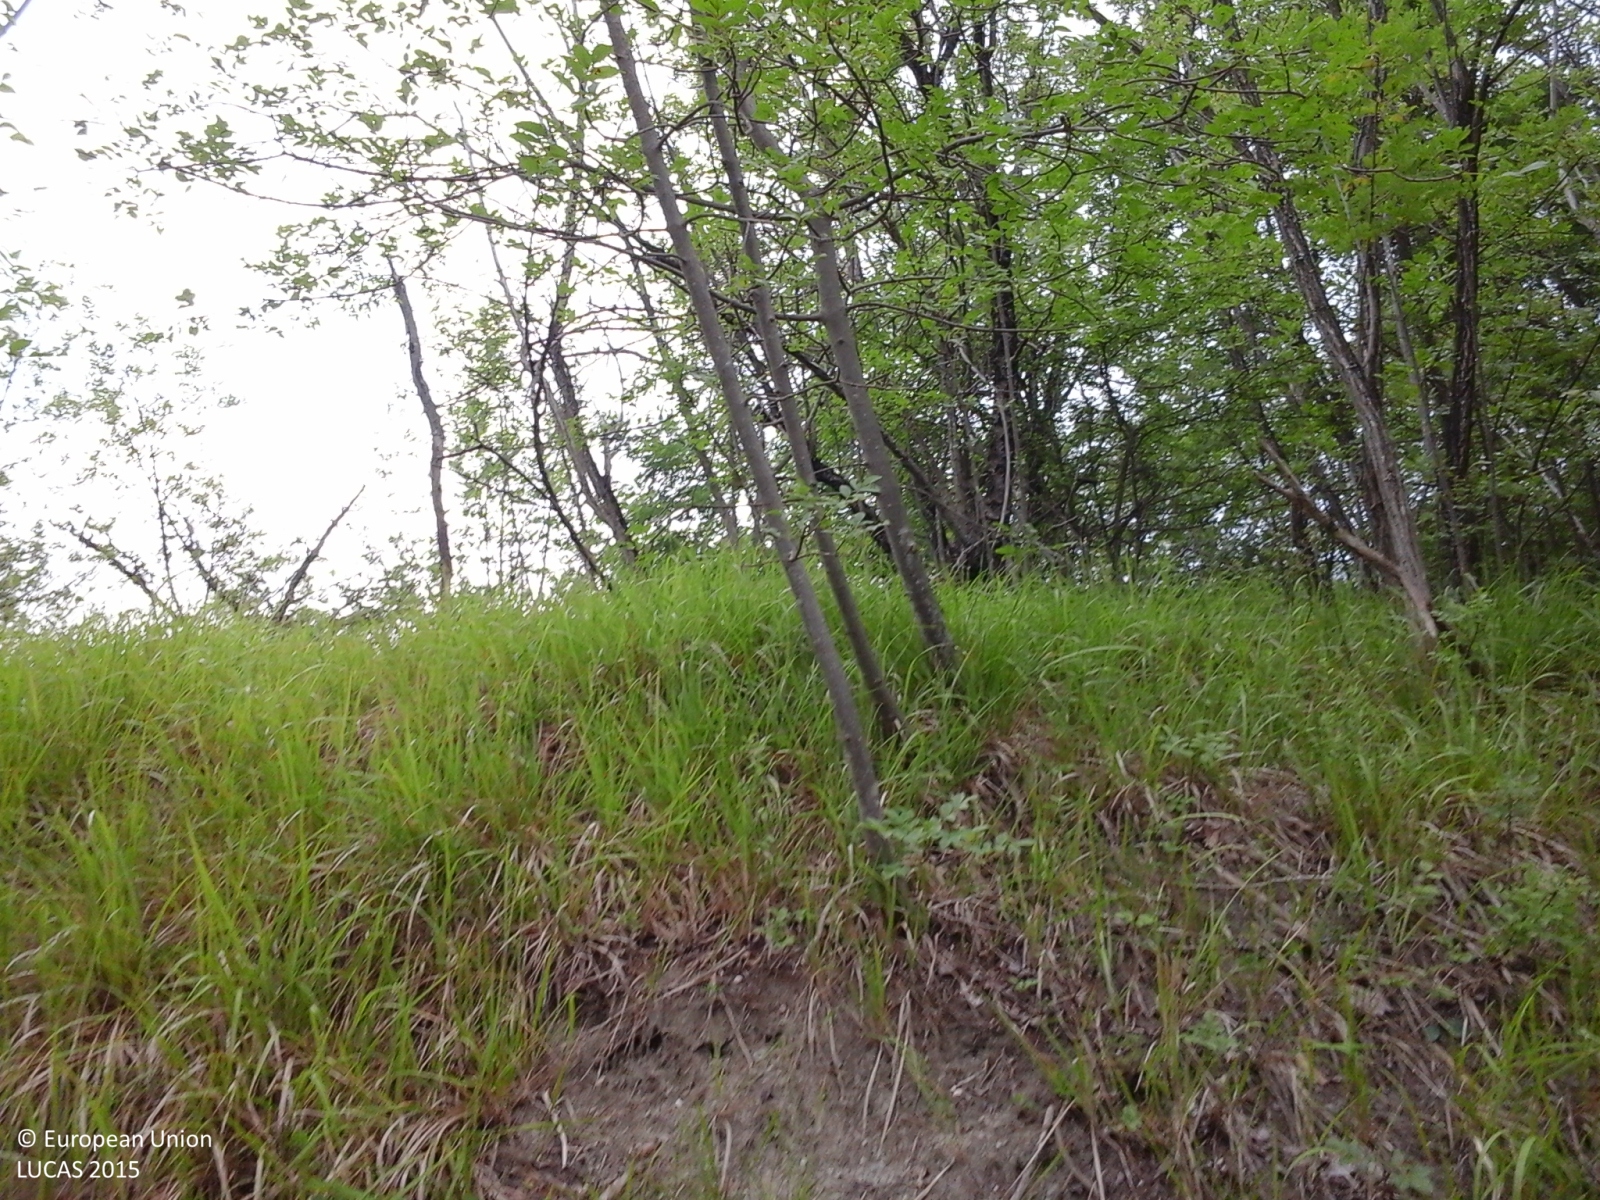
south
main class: Woodland
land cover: Broadleaved woodland
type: thermophilous deciduous forest
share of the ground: > 75 %
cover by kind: broadleaved forest trees 65 %, herbaceous plants 25 %, shrubs 10 %
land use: Forestry
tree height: < 5 m
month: June
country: IT
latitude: 44.6107
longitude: 8.5288
